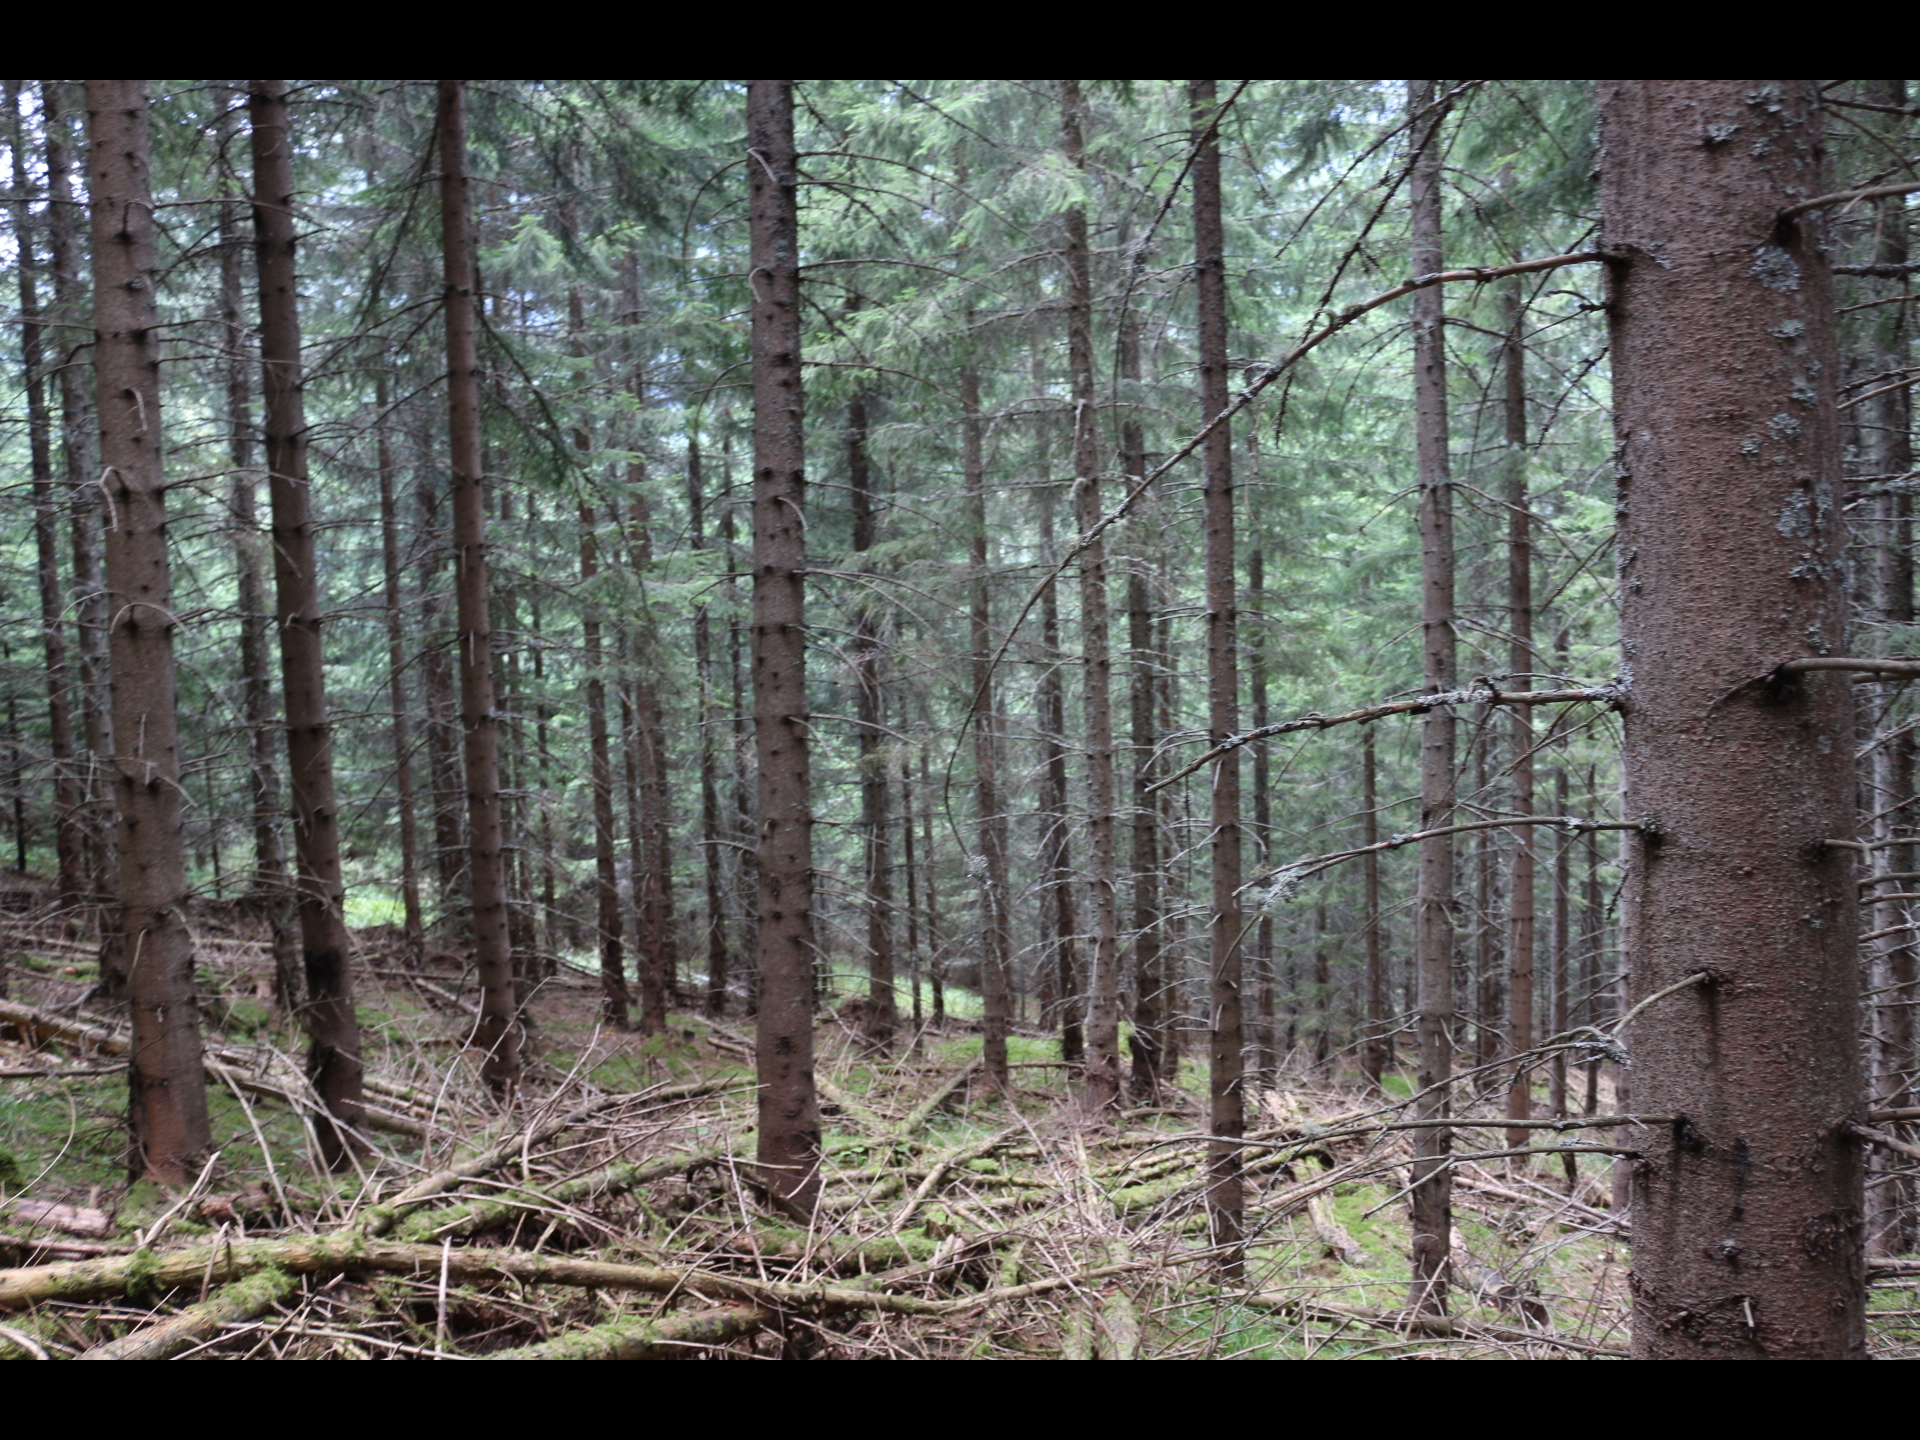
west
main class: Woodland
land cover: Spruce dominated coniferous woodland
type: alpine coniferous forest
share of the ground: > 75 %
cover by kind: coniferous forest trees 85 %, lichens and mosses 10 %, unconsolidated bare surface 5 %
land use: Forestry
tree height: > 5 m
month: August
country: AT
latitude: 46.9414
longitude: 14.0571
